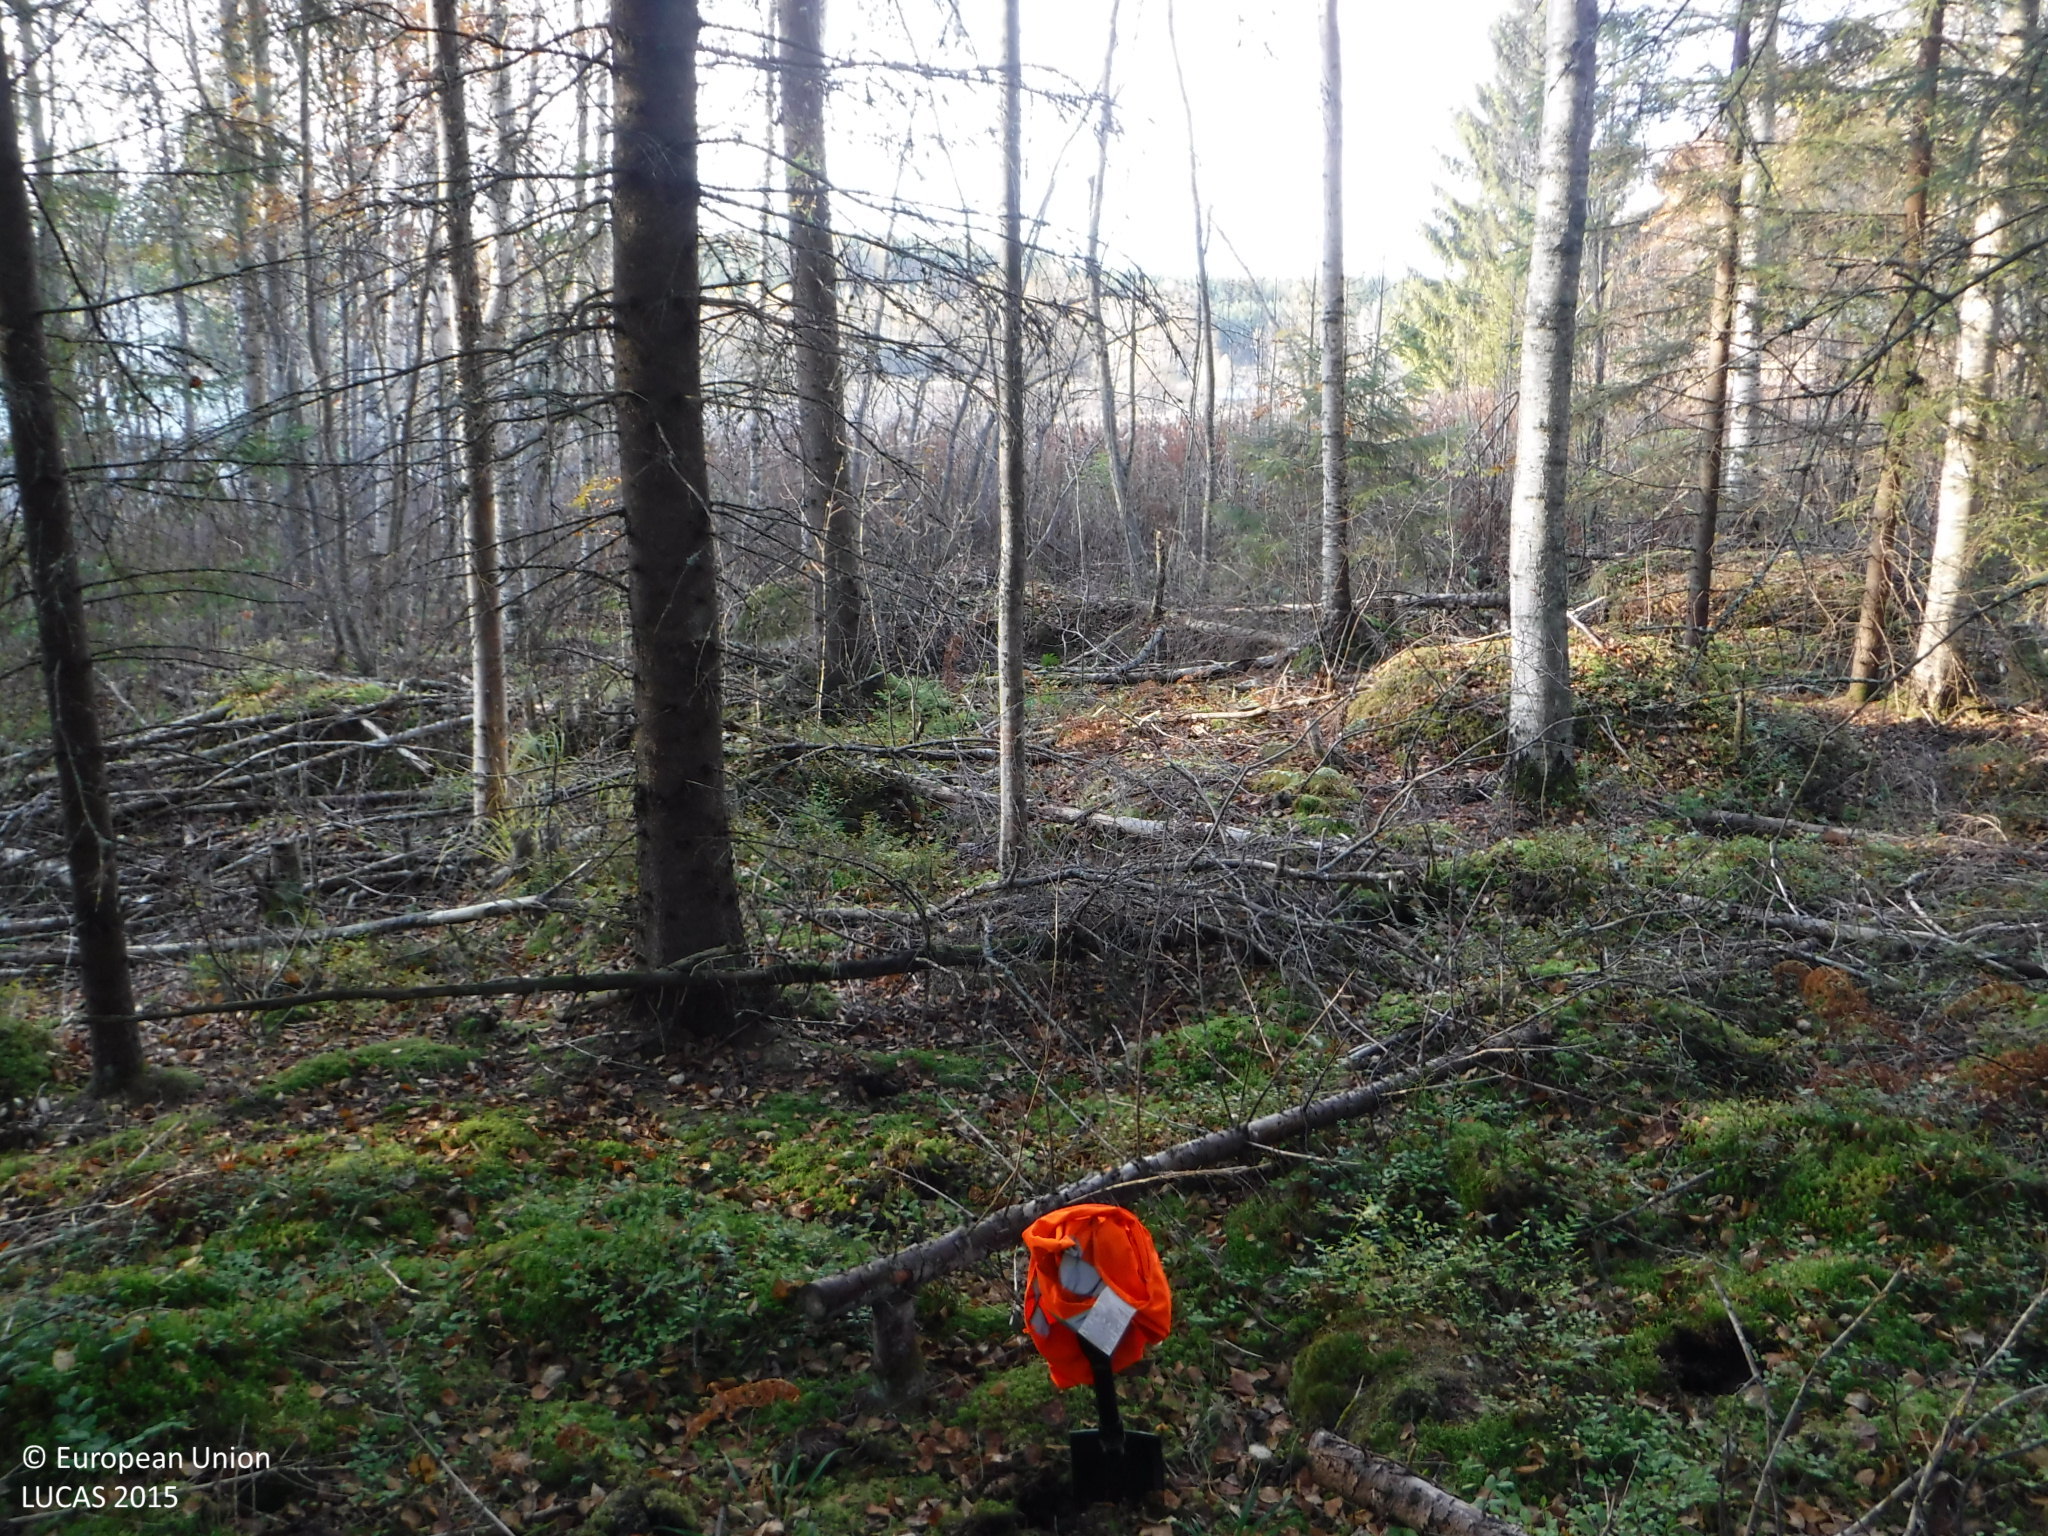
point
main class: Woodland
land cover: Spruce dominated mixed woodland
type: boreal forest
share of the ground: > 75 %
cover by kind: coniferous forest trees 45 %, broadleaved forest trees 35 %, lichens and mosses 15 %, shrubs 5 %
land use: Forestry
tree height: > 5 m
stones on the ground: > 50 %
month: October
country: FI
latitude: 62.0498
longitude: 25.9435
